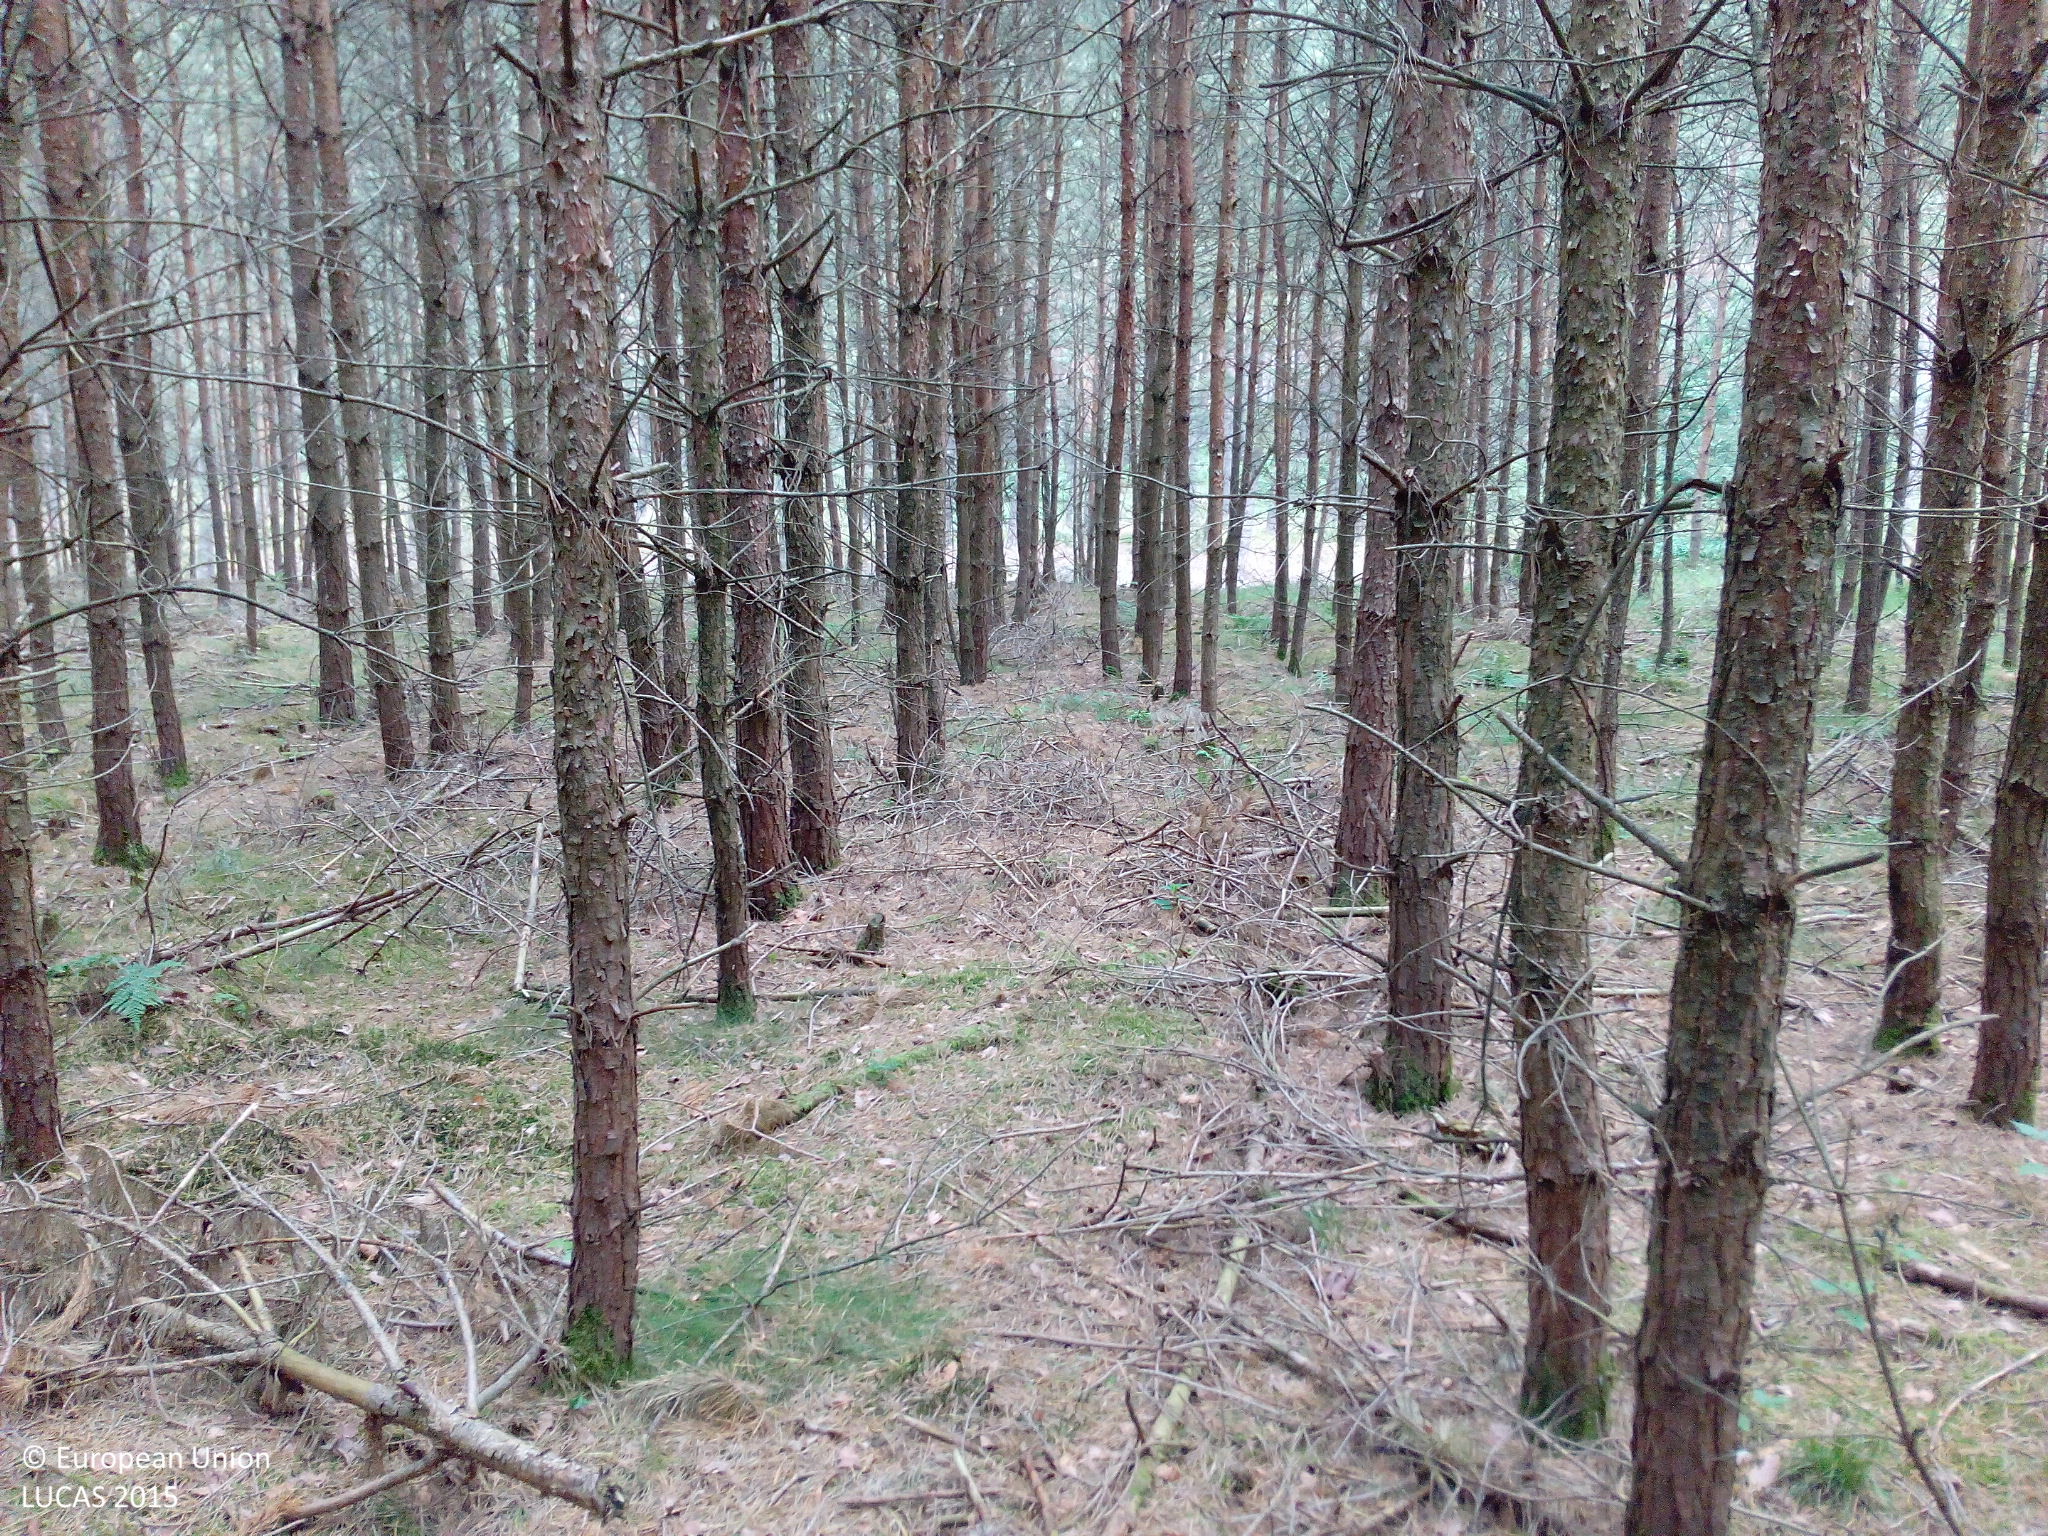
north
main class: Woodland
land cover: Pine dominated coniferous woodland
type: mountainous beech forest
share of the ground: > 75 %
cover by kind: coniferous forest trees 95 %, unconsolidated bare surface 5 %
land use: Forestry
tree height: > 5 m
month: June
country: DE
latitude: 52.1546
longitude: 12.4406
